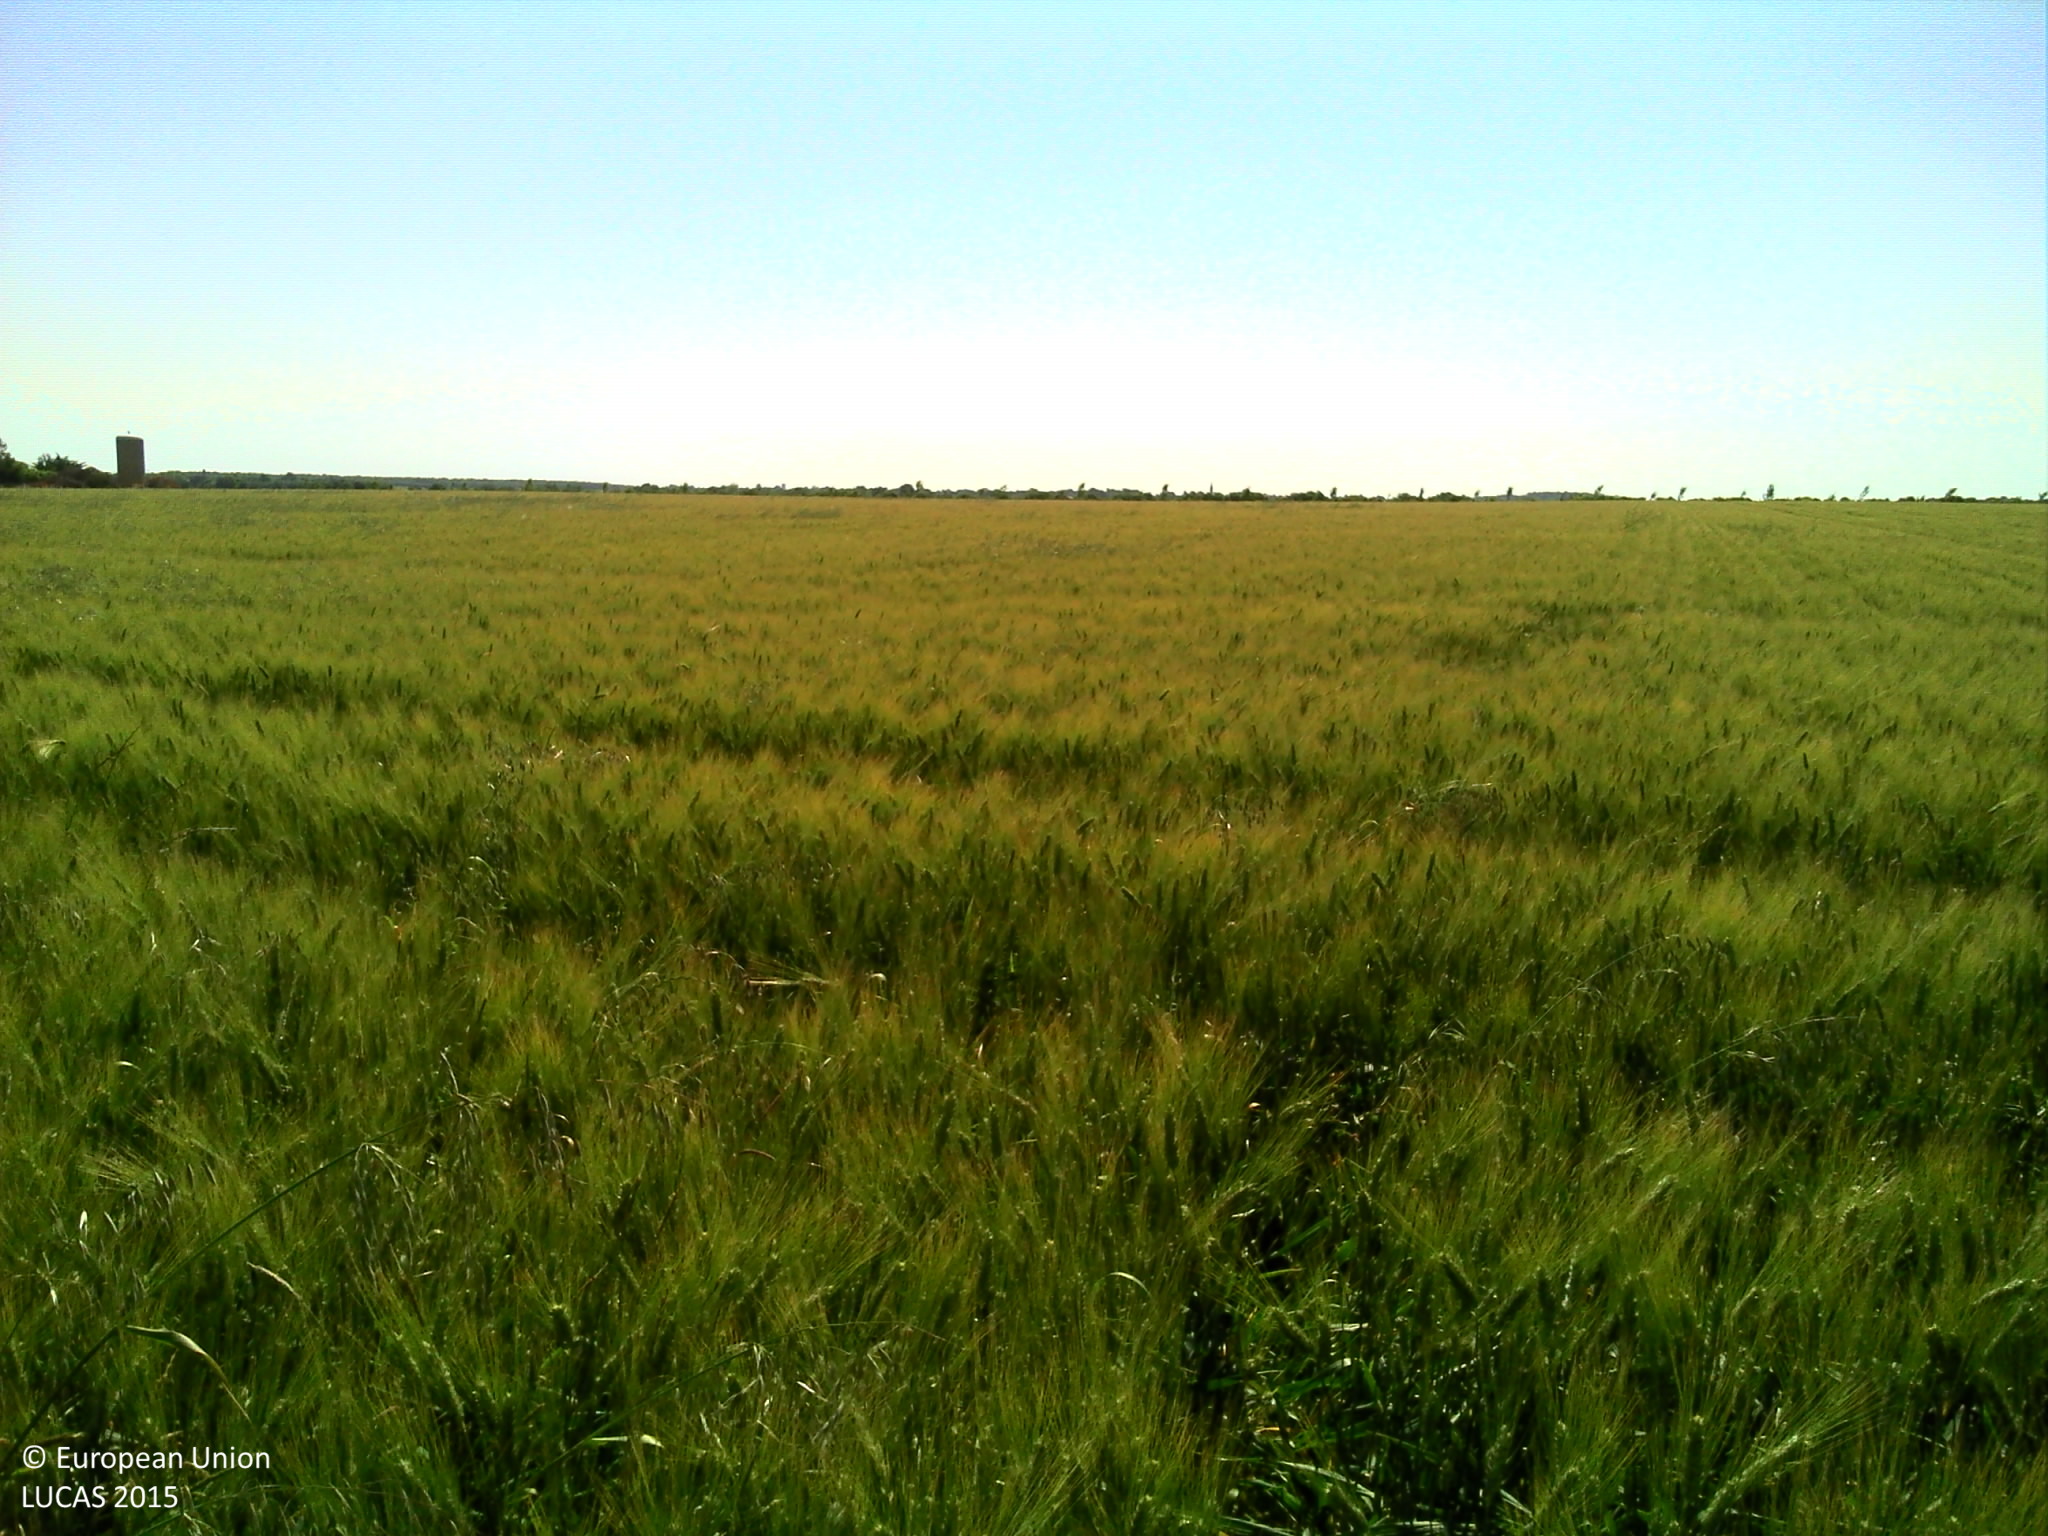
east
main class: Cropland
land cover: Durum wheat
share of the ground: > 75 %
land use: Agriculture (excluding fallow land and kitchen gardens)
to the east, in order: Durum wheat; Lines of trees; Grass margins; Paved roads, cycling and walking lanes; Grass margins; Lines of trees; Grass margins; Lines of trees; Grass margins; Durum wheat
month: June
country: FR
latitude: 46.1762
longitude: -1.0544
